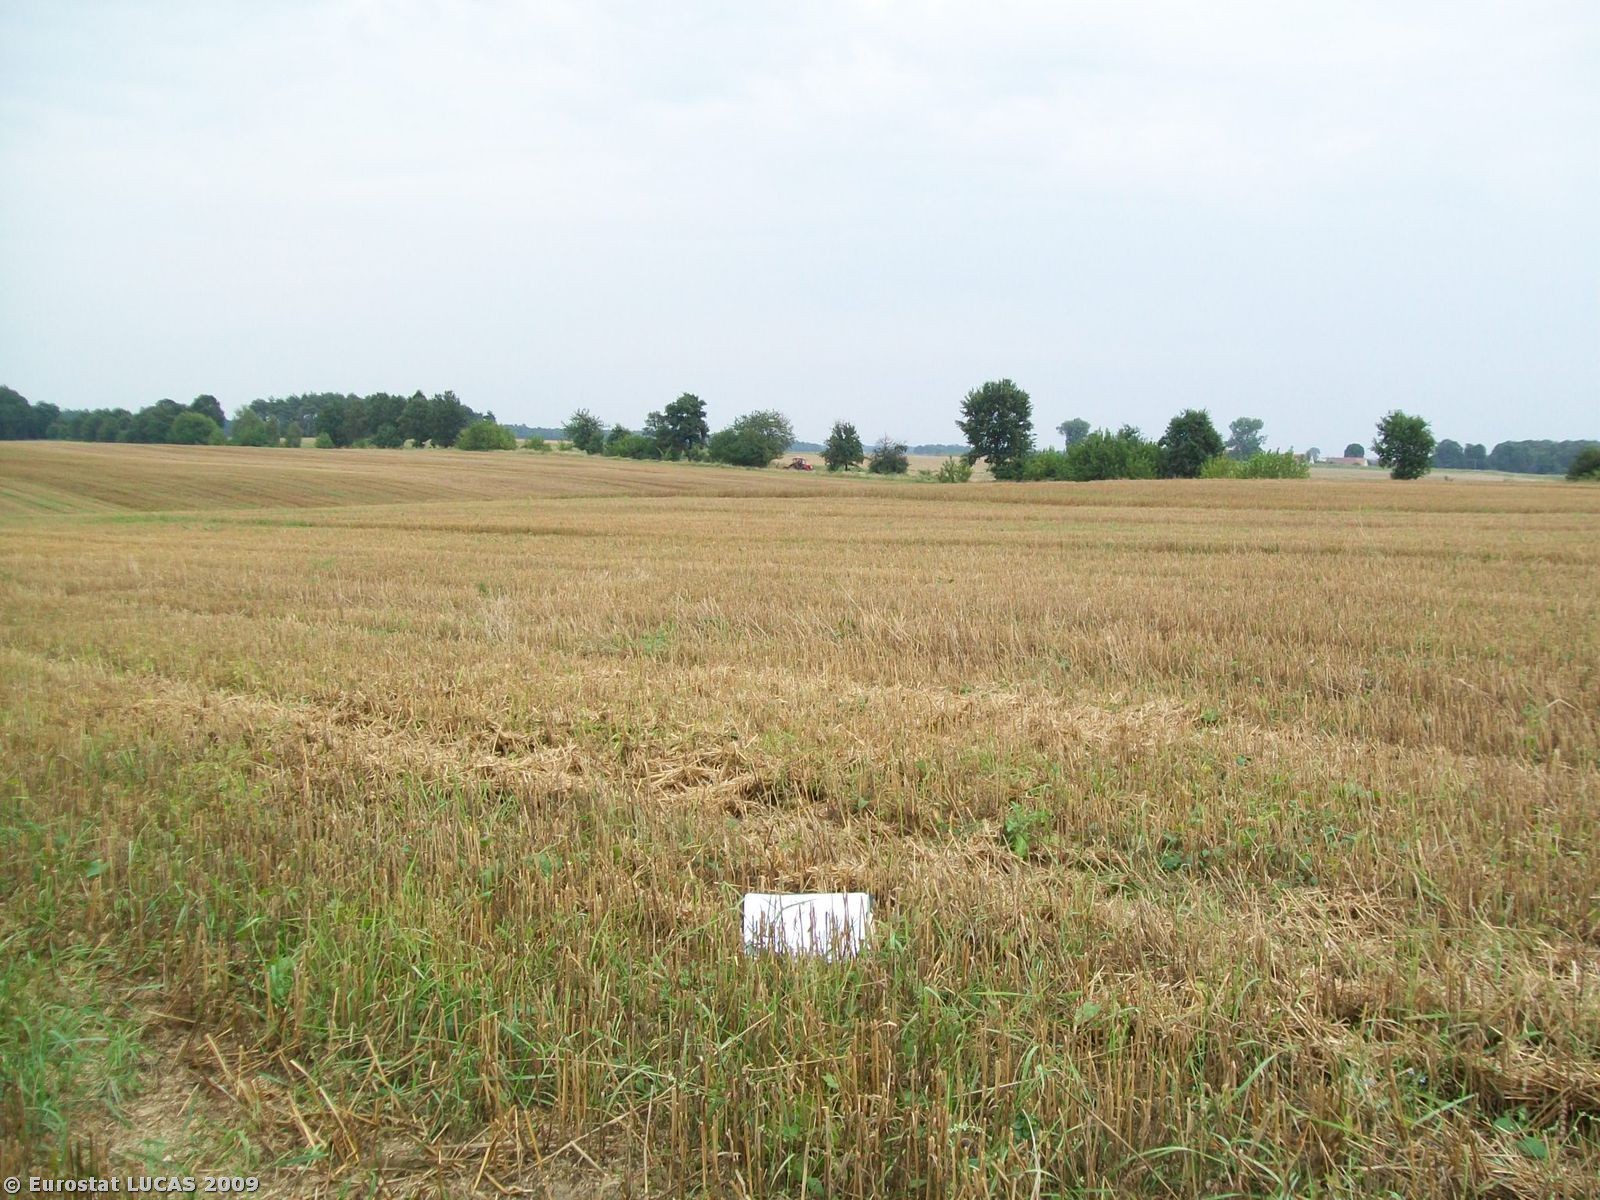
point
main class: Cropland
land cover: Common wheat
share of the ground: < 10 %
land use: Agriculture (excluding fallow land and kitchen gardens)
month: August
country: PL
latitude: 51.0995
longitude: 17.9411
